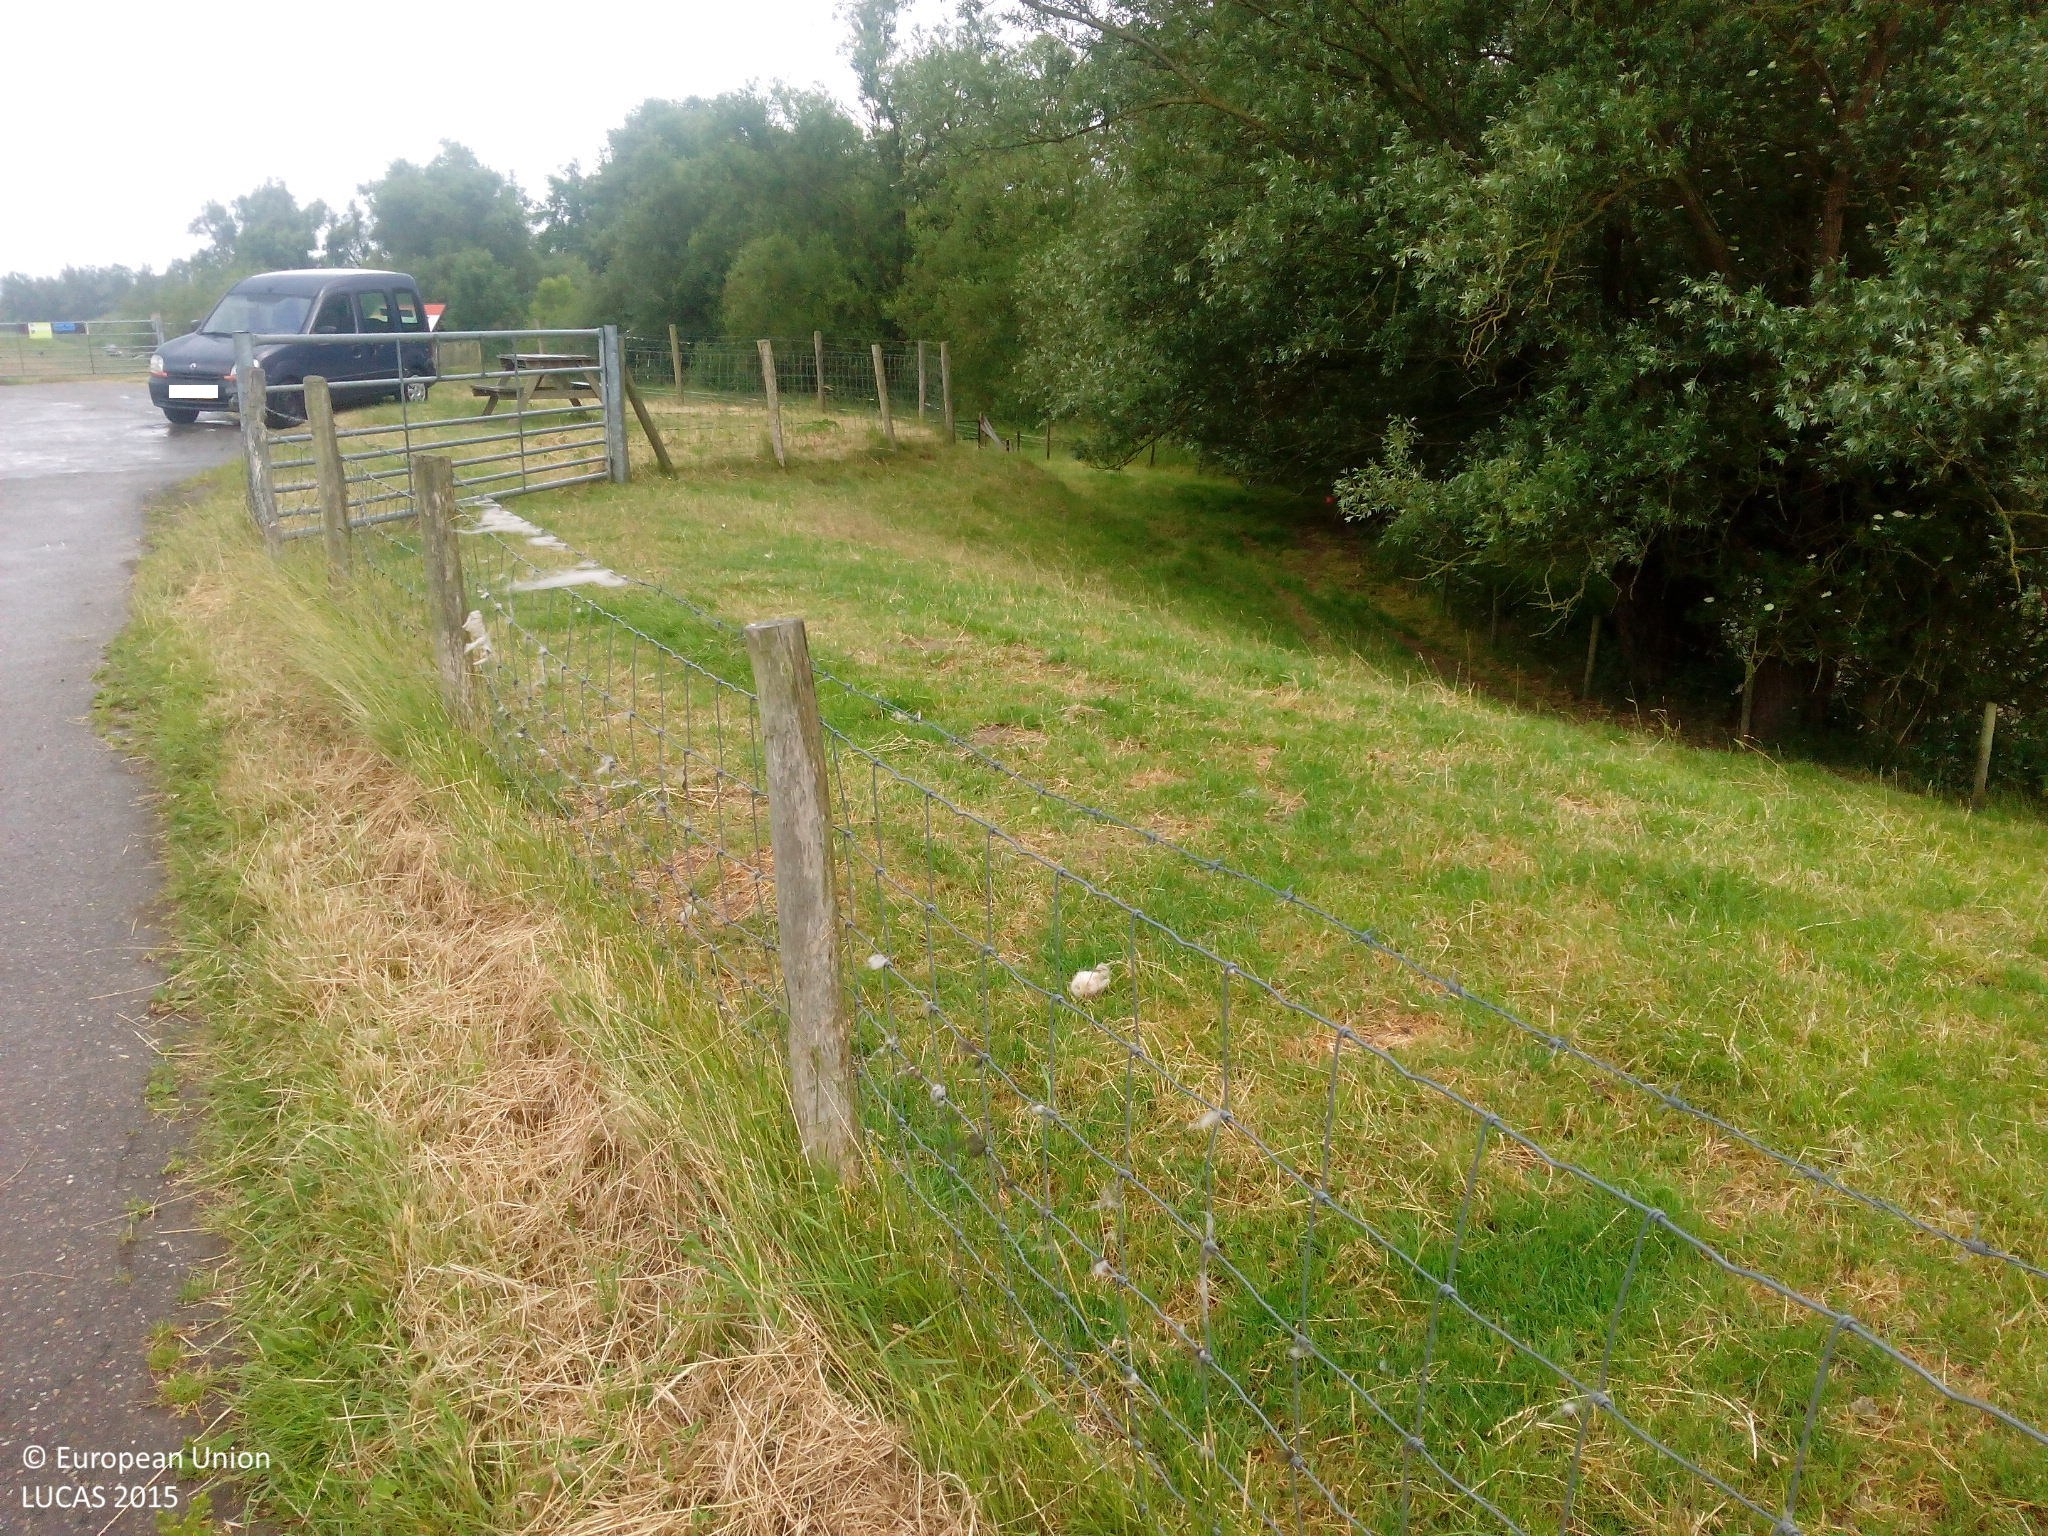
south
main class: Woodland
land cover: Broadleaved woodland
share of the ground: > 75 %
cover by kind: broadleaved forest trees 90 %, herbaceous plants 10 %
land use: Semi-natural and natural areas not in use
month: June
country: NL
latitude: 51.7538
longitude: 4.6799
